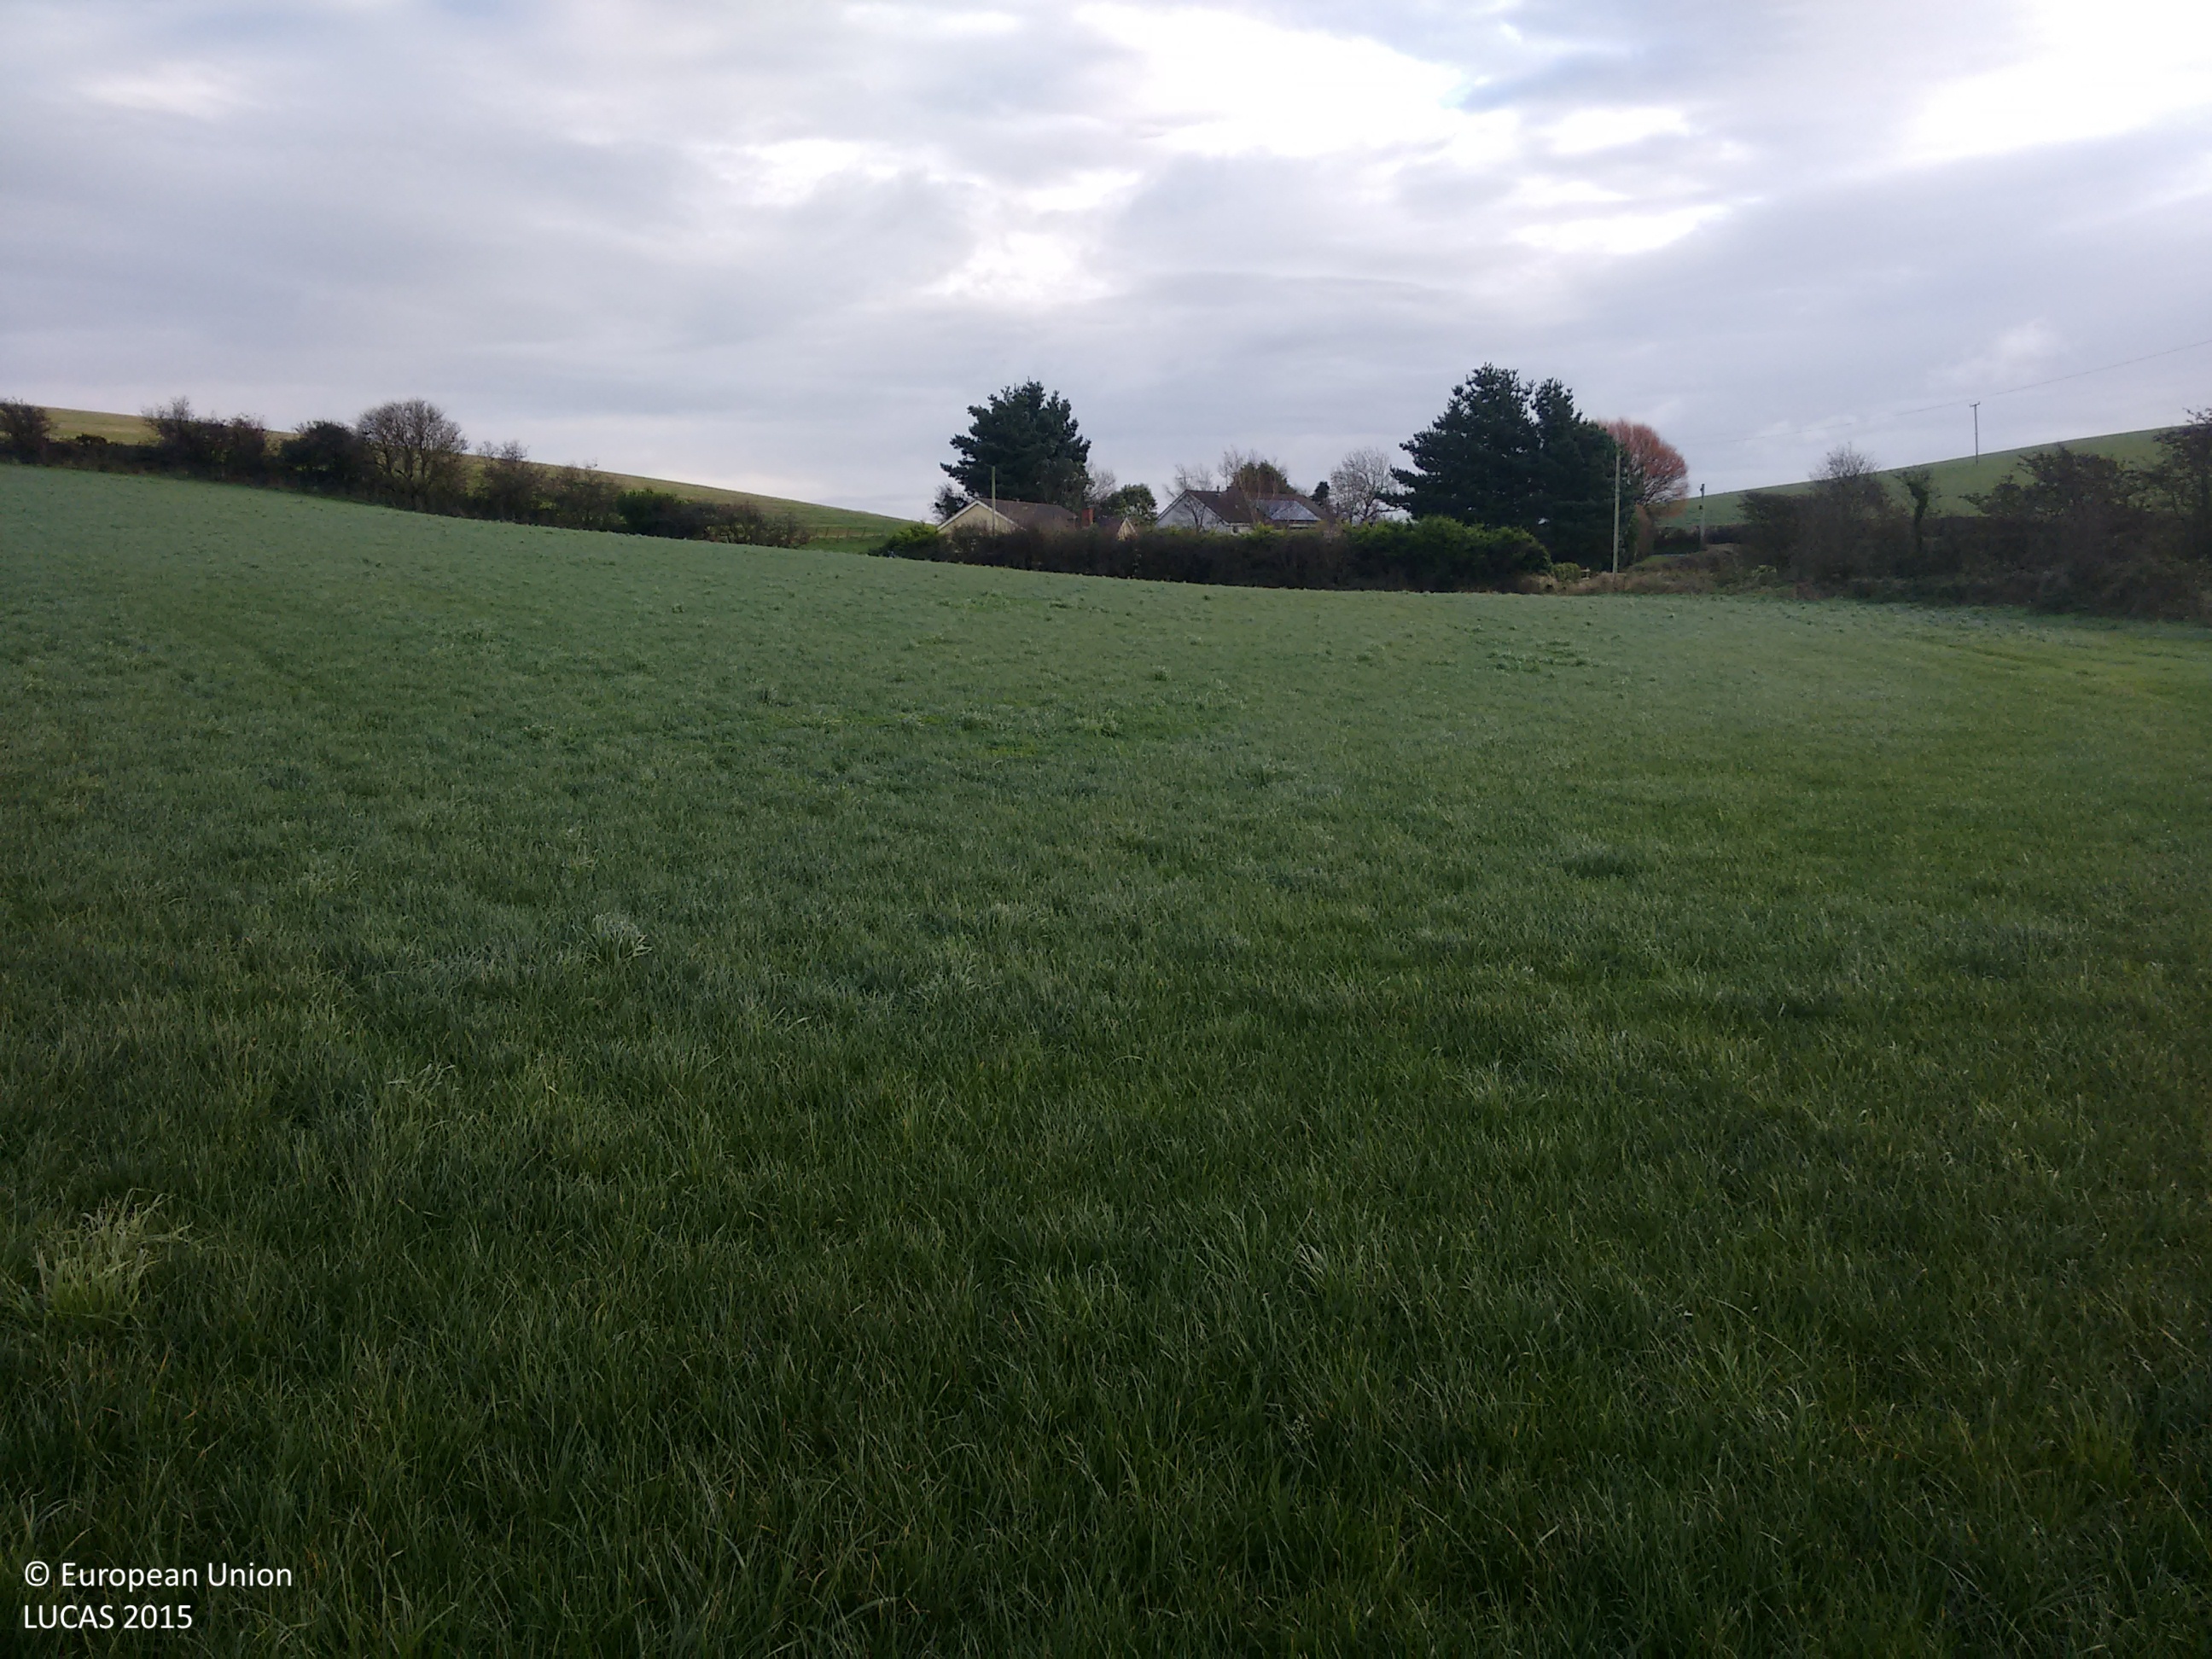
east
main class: Grassland
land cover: Grassland without tree/shrub cover
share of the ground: > 75 %
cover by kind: herbaceous plants 100 %
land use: Agriculture (excluding fallow land and kitchen gardens)
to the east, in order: Grassland without tree/shrub cover; Abandoned hedges; Artificial constructions in urban areas; Abandoned hedges; Grass margins; Barley; Electric lines; Barley; Abandoned hedges
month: November
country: GB
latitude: 54.3919
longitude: -5.5133
